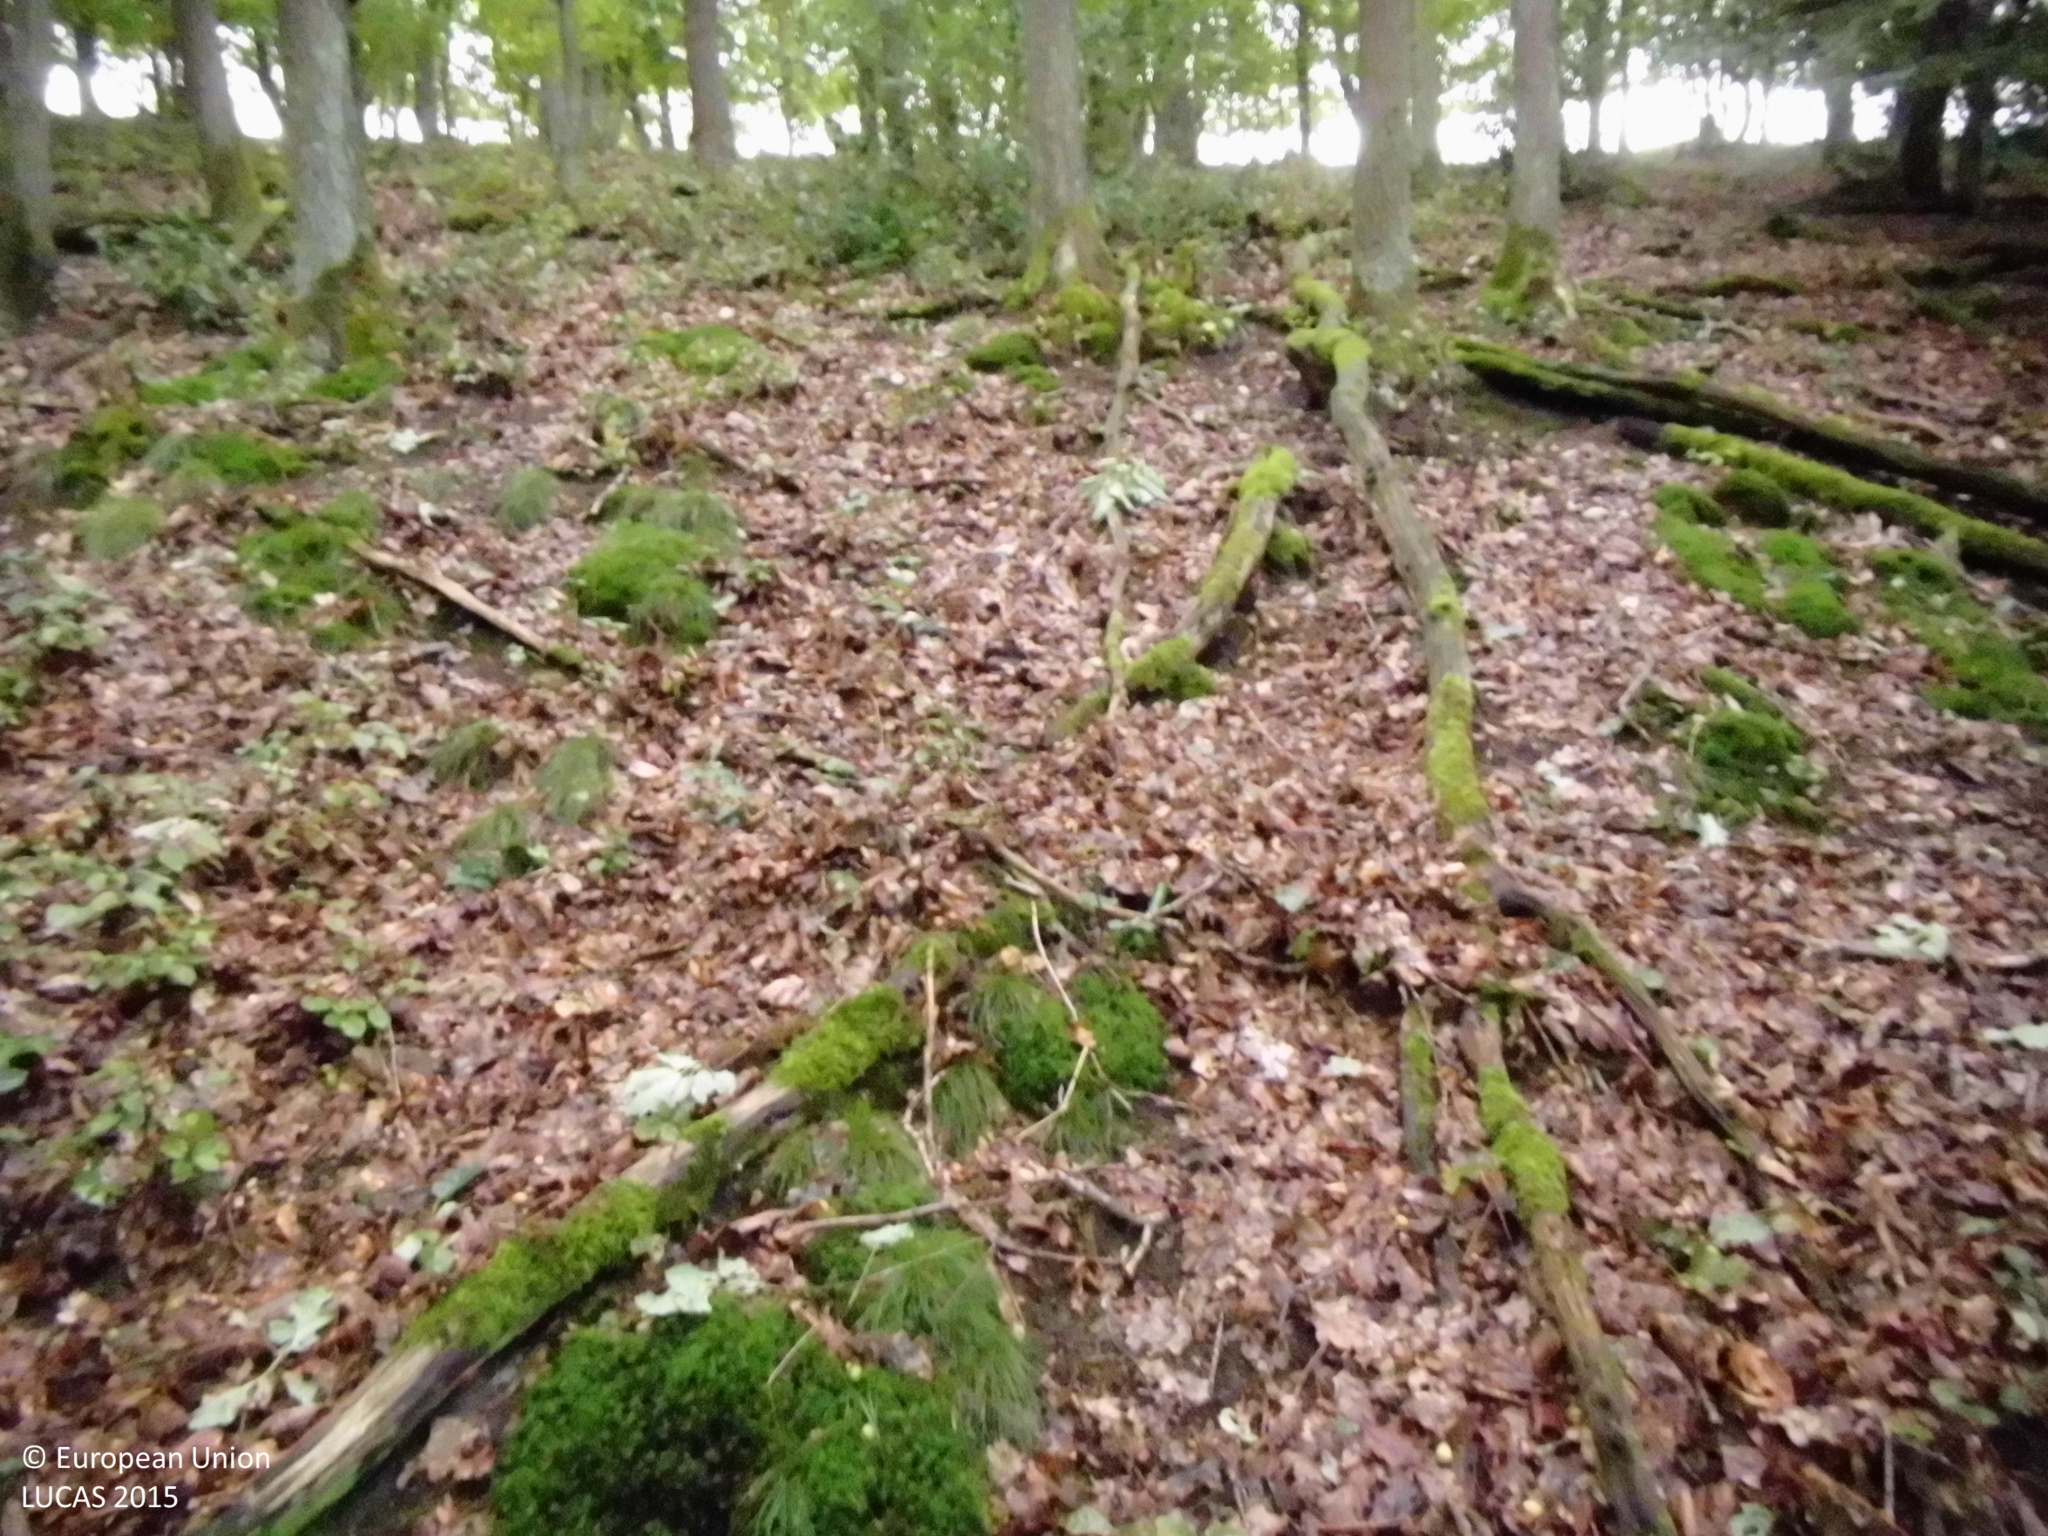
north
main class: Woodland
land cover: Broadleaved woodland
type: mesophytic deciduous forest
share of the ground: > 75 %
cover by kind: broadleaved forest trees 100 %
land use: Forestry
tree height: > 5 m
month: September
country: DE
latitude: 50.5874
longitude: 7.4437
